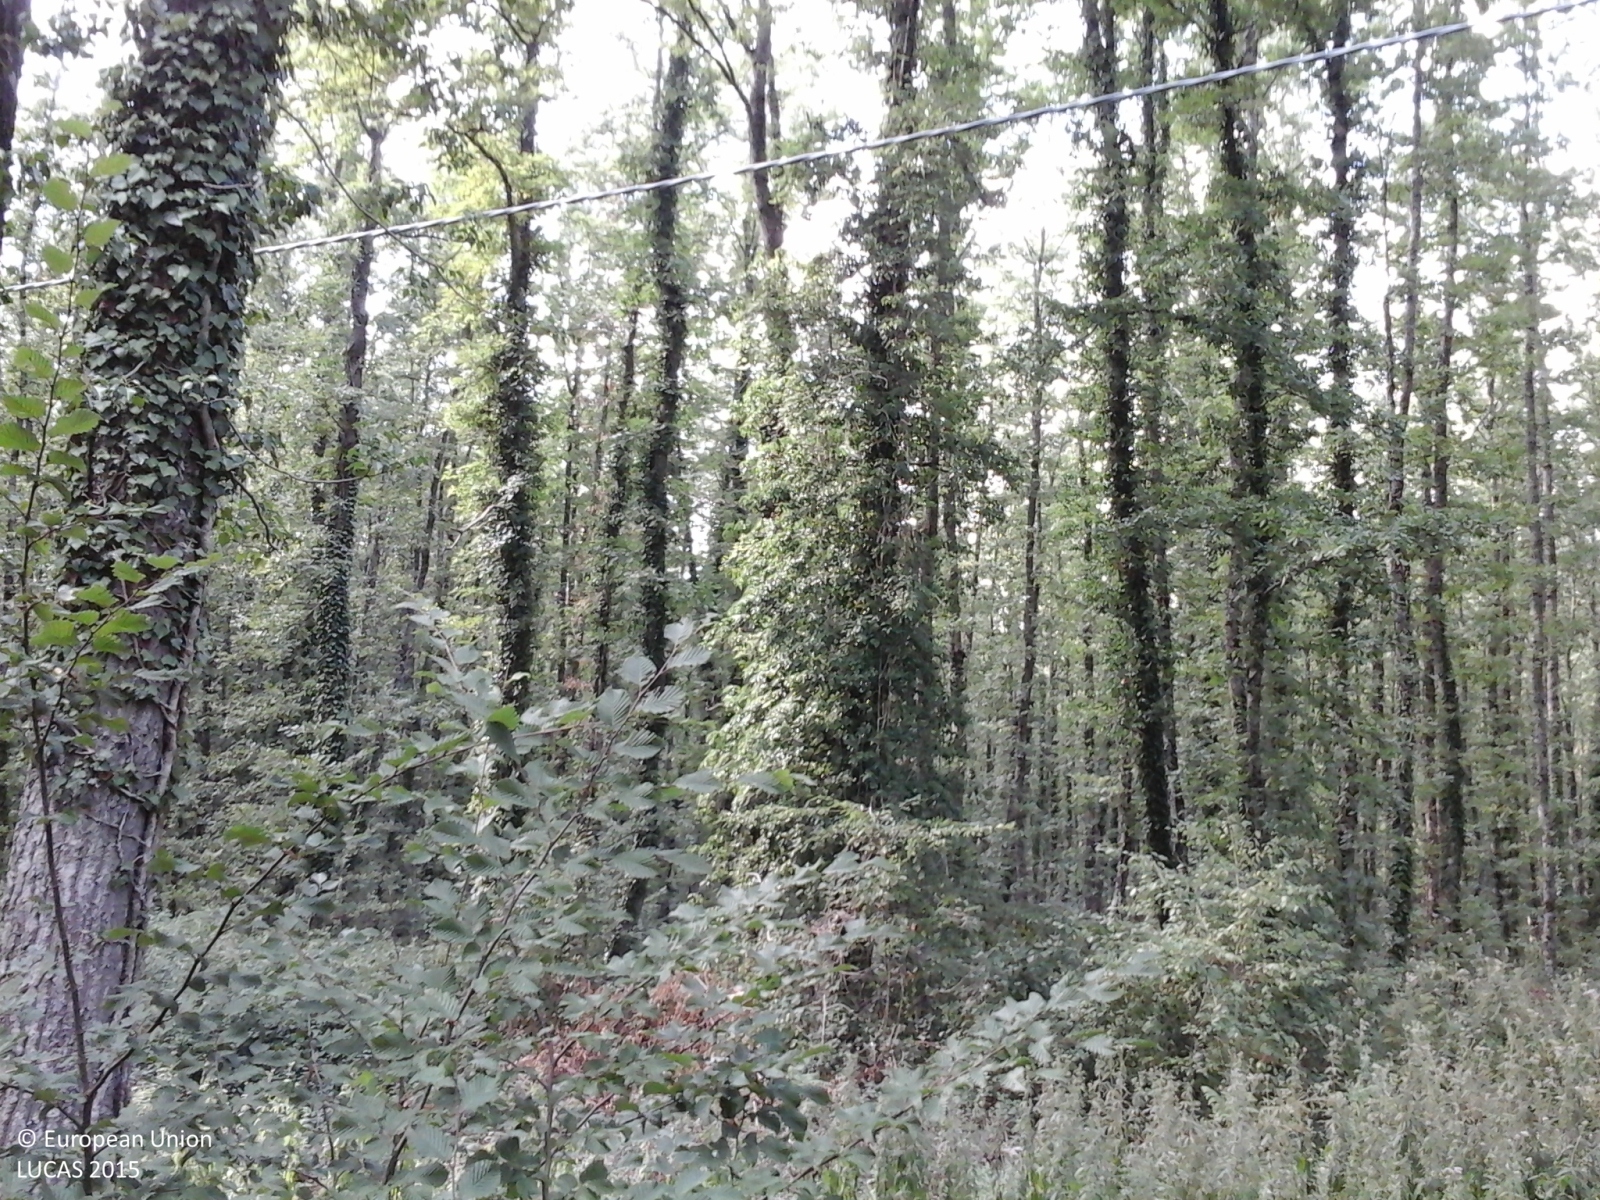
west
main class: Woodland
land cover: Broadleaved woodland
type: thermophilous deciduous forest
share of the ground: > 75 %
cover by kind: broadleaved forest trees 70 %, shrubs 20 %, herbaceous plants 10 %
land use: Forestry
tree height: > 5 m
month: August
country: IT
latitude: 41.7135
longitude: 14.2759
